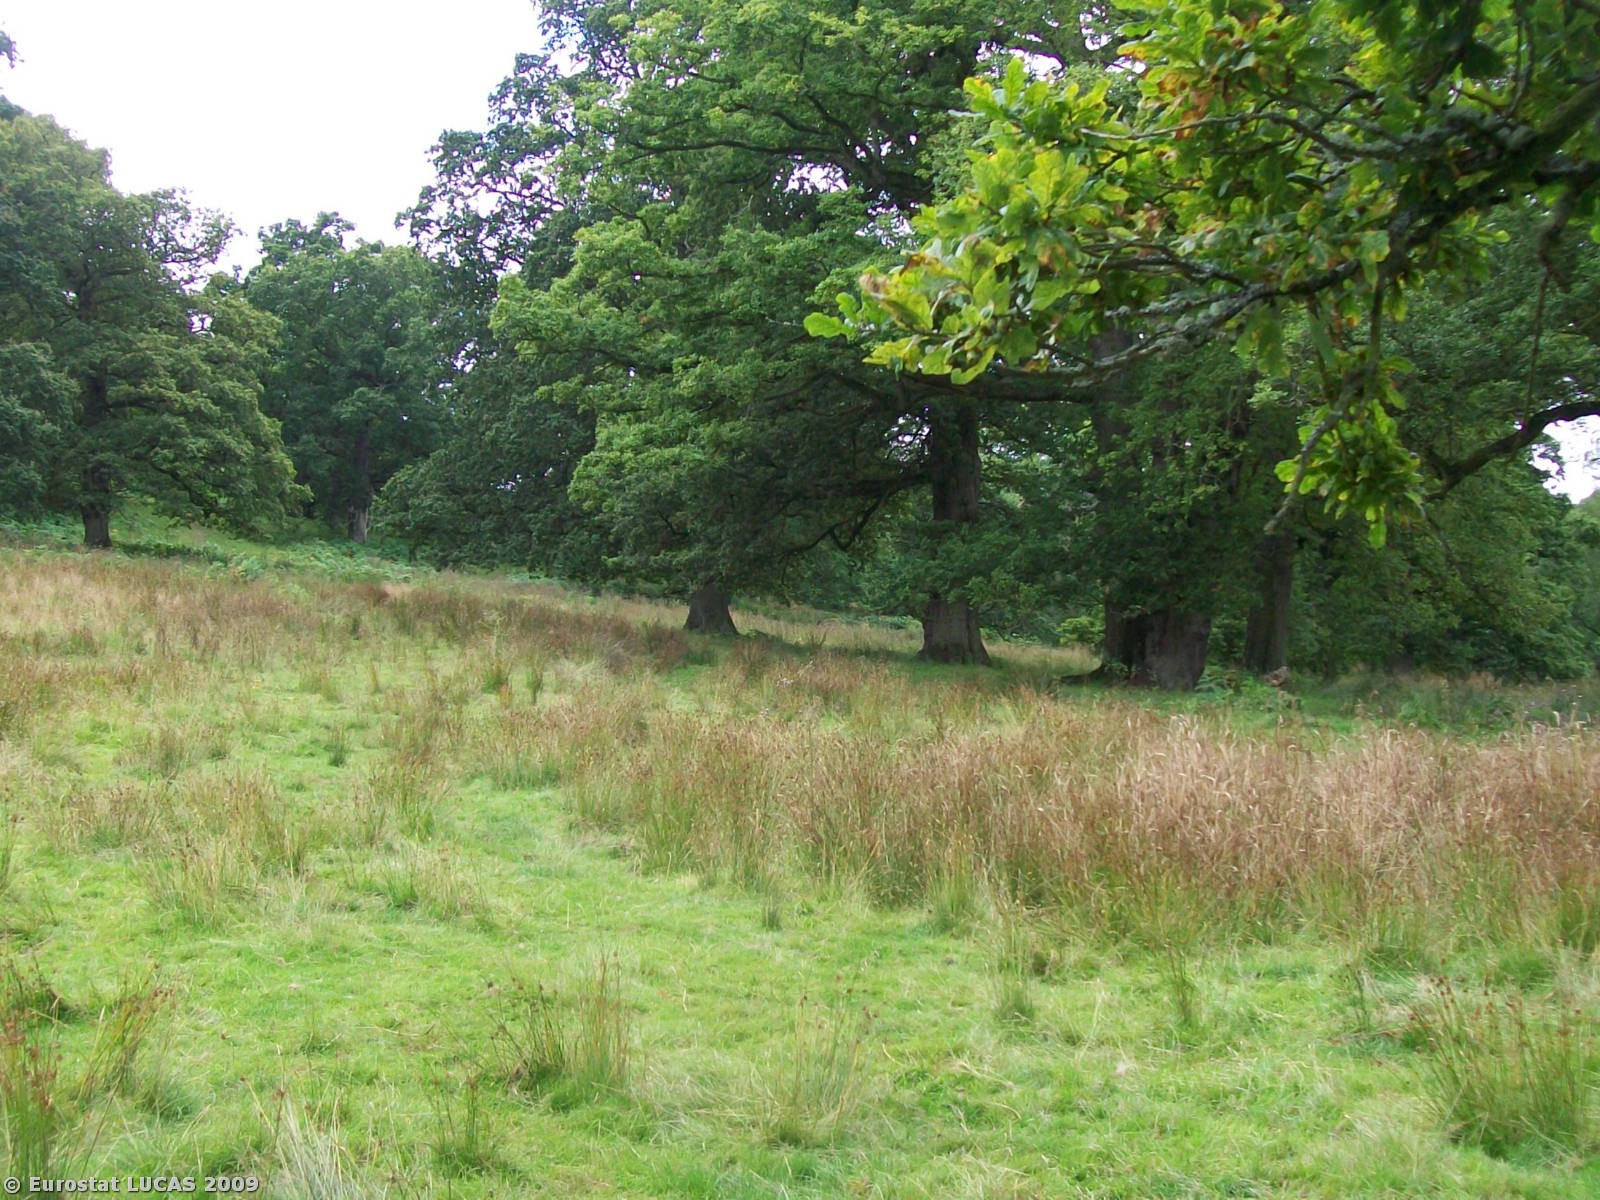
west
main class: Grassland
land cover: Grassland with sparse tree/shrub cover
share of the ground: > 75 %
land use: Agriculture (excluding fallow land and kitchen gardens)
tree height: > 5 m
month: August
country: GB
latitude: 52.5678
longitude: -3.3448
